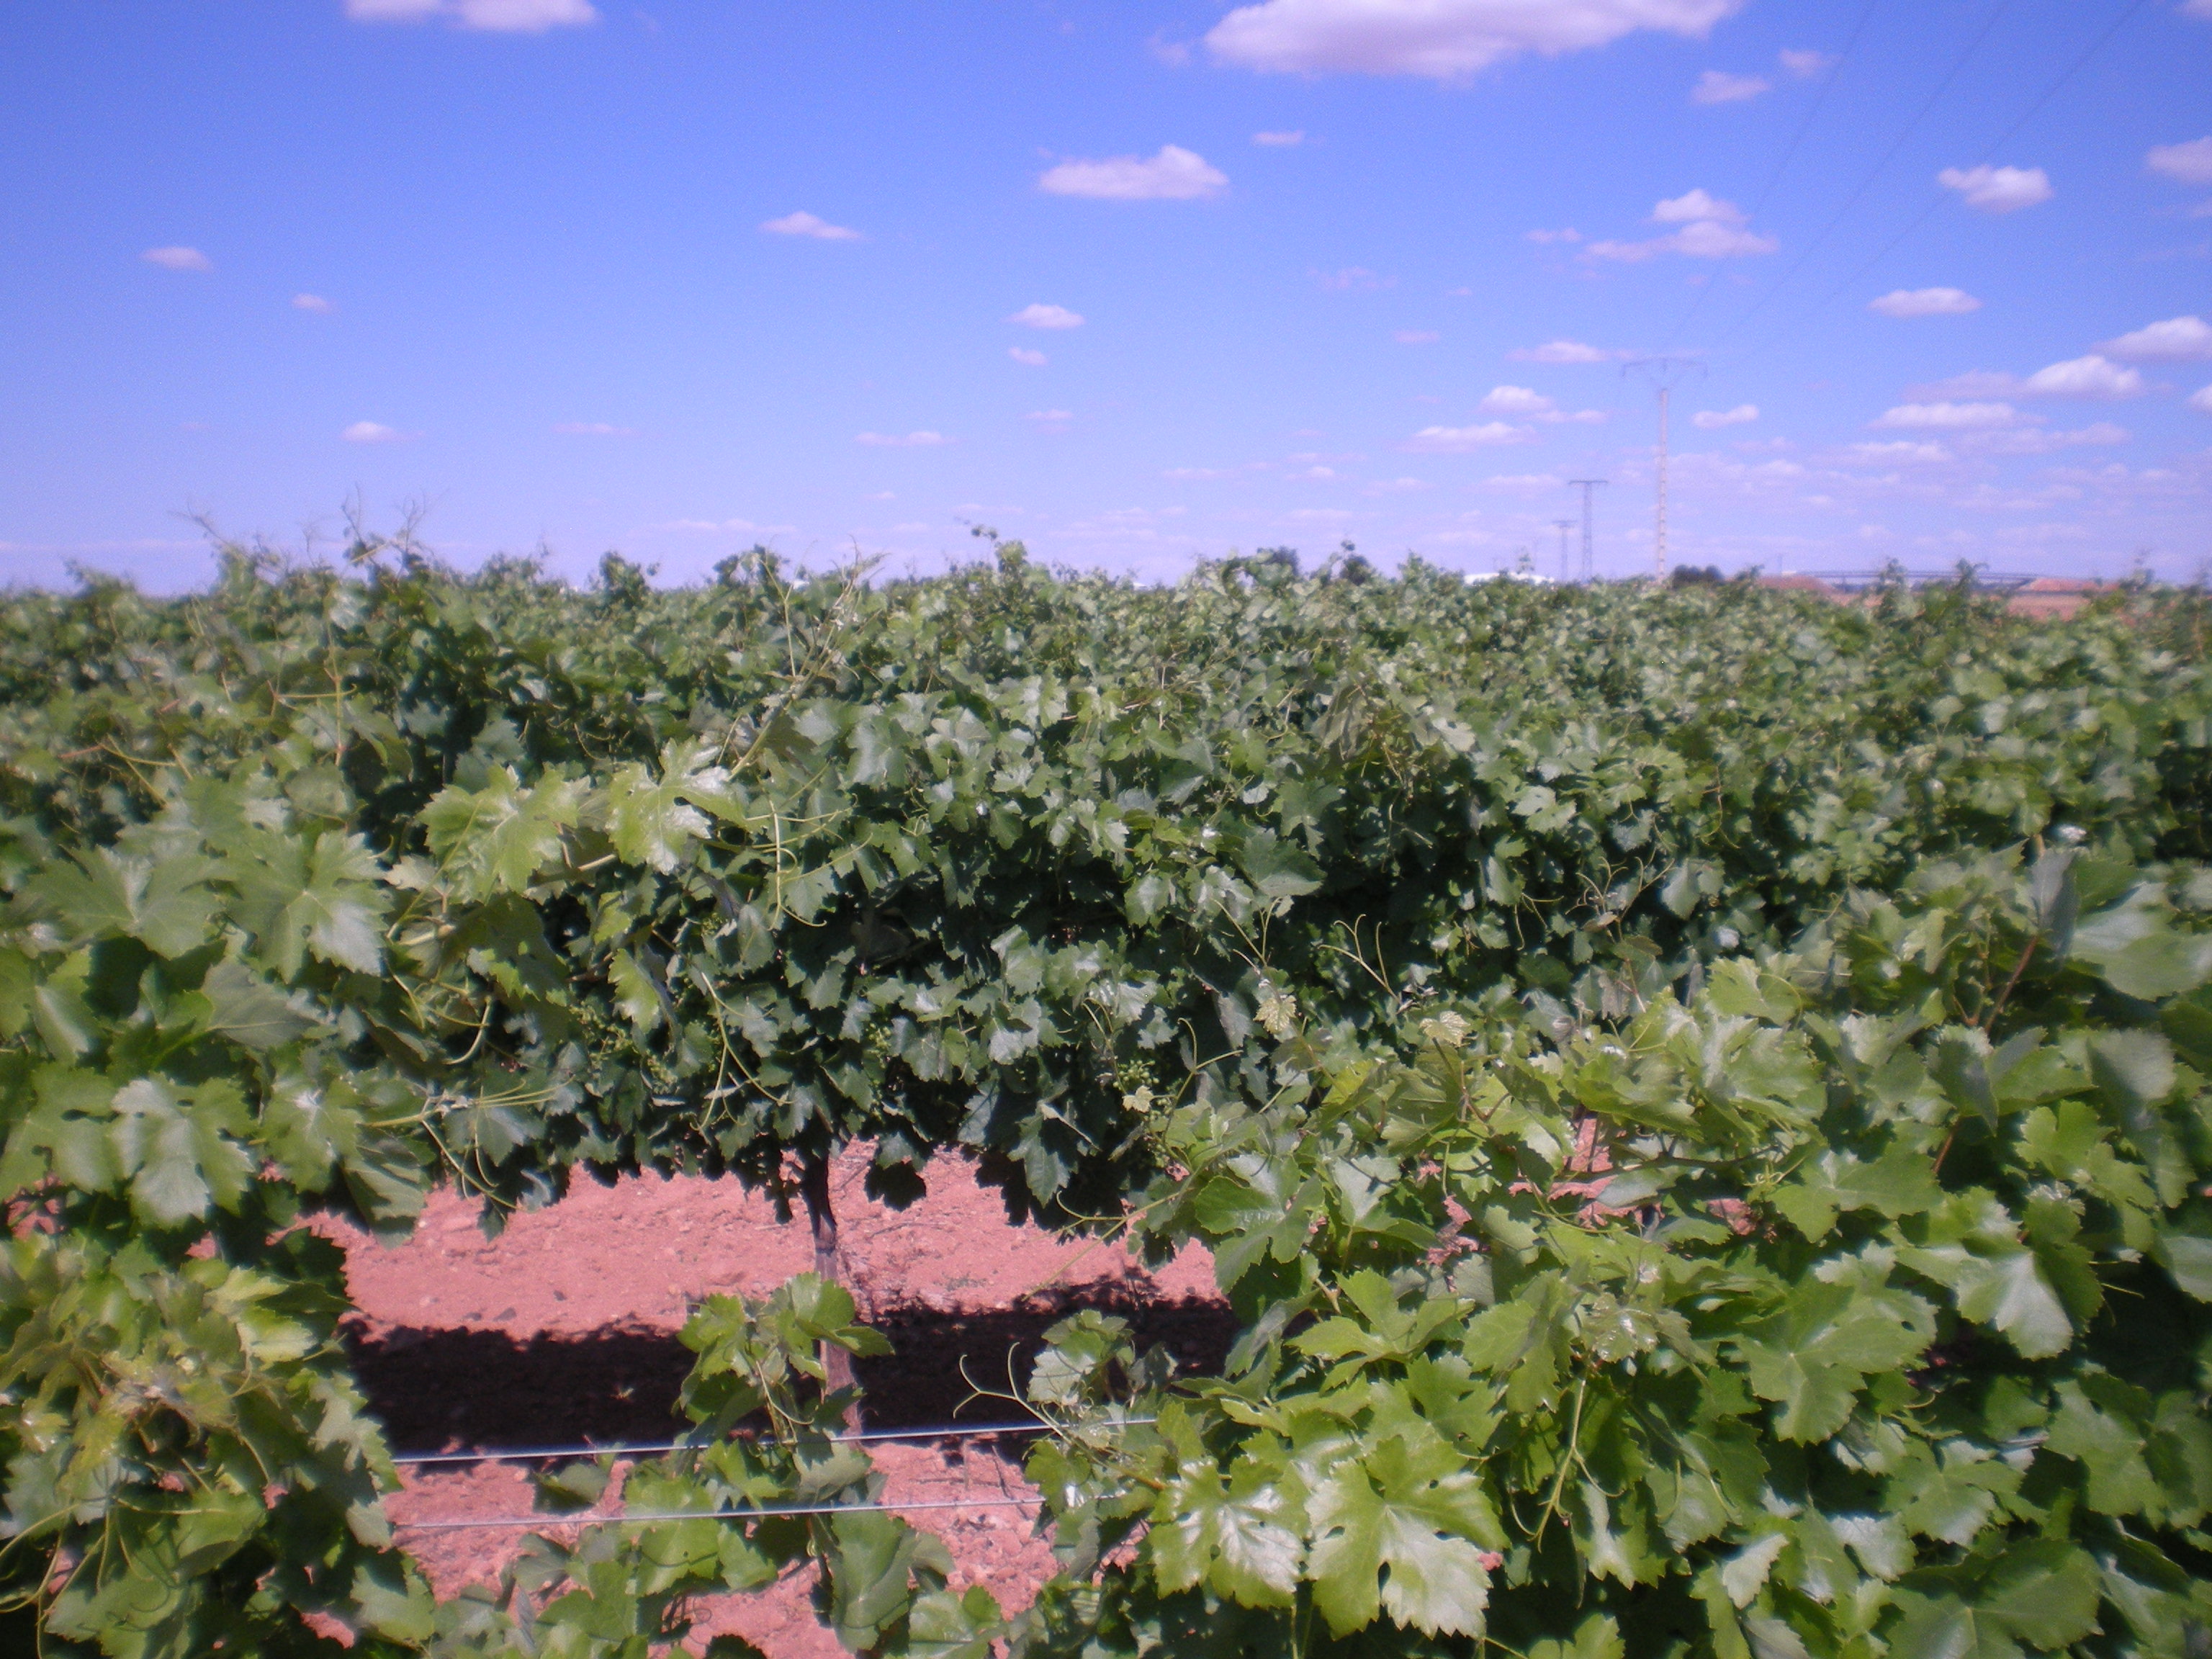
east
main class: Cropland
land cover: Vineyards
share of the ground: 10 - 25 %
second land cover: Other bare soil
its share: > 75 %
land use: Agriculture (excluding fallow land and kitchen gardens)
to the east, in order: Vineyards; Other bare soil
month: June
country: ES
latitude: 39.1623
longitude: -2.9859
